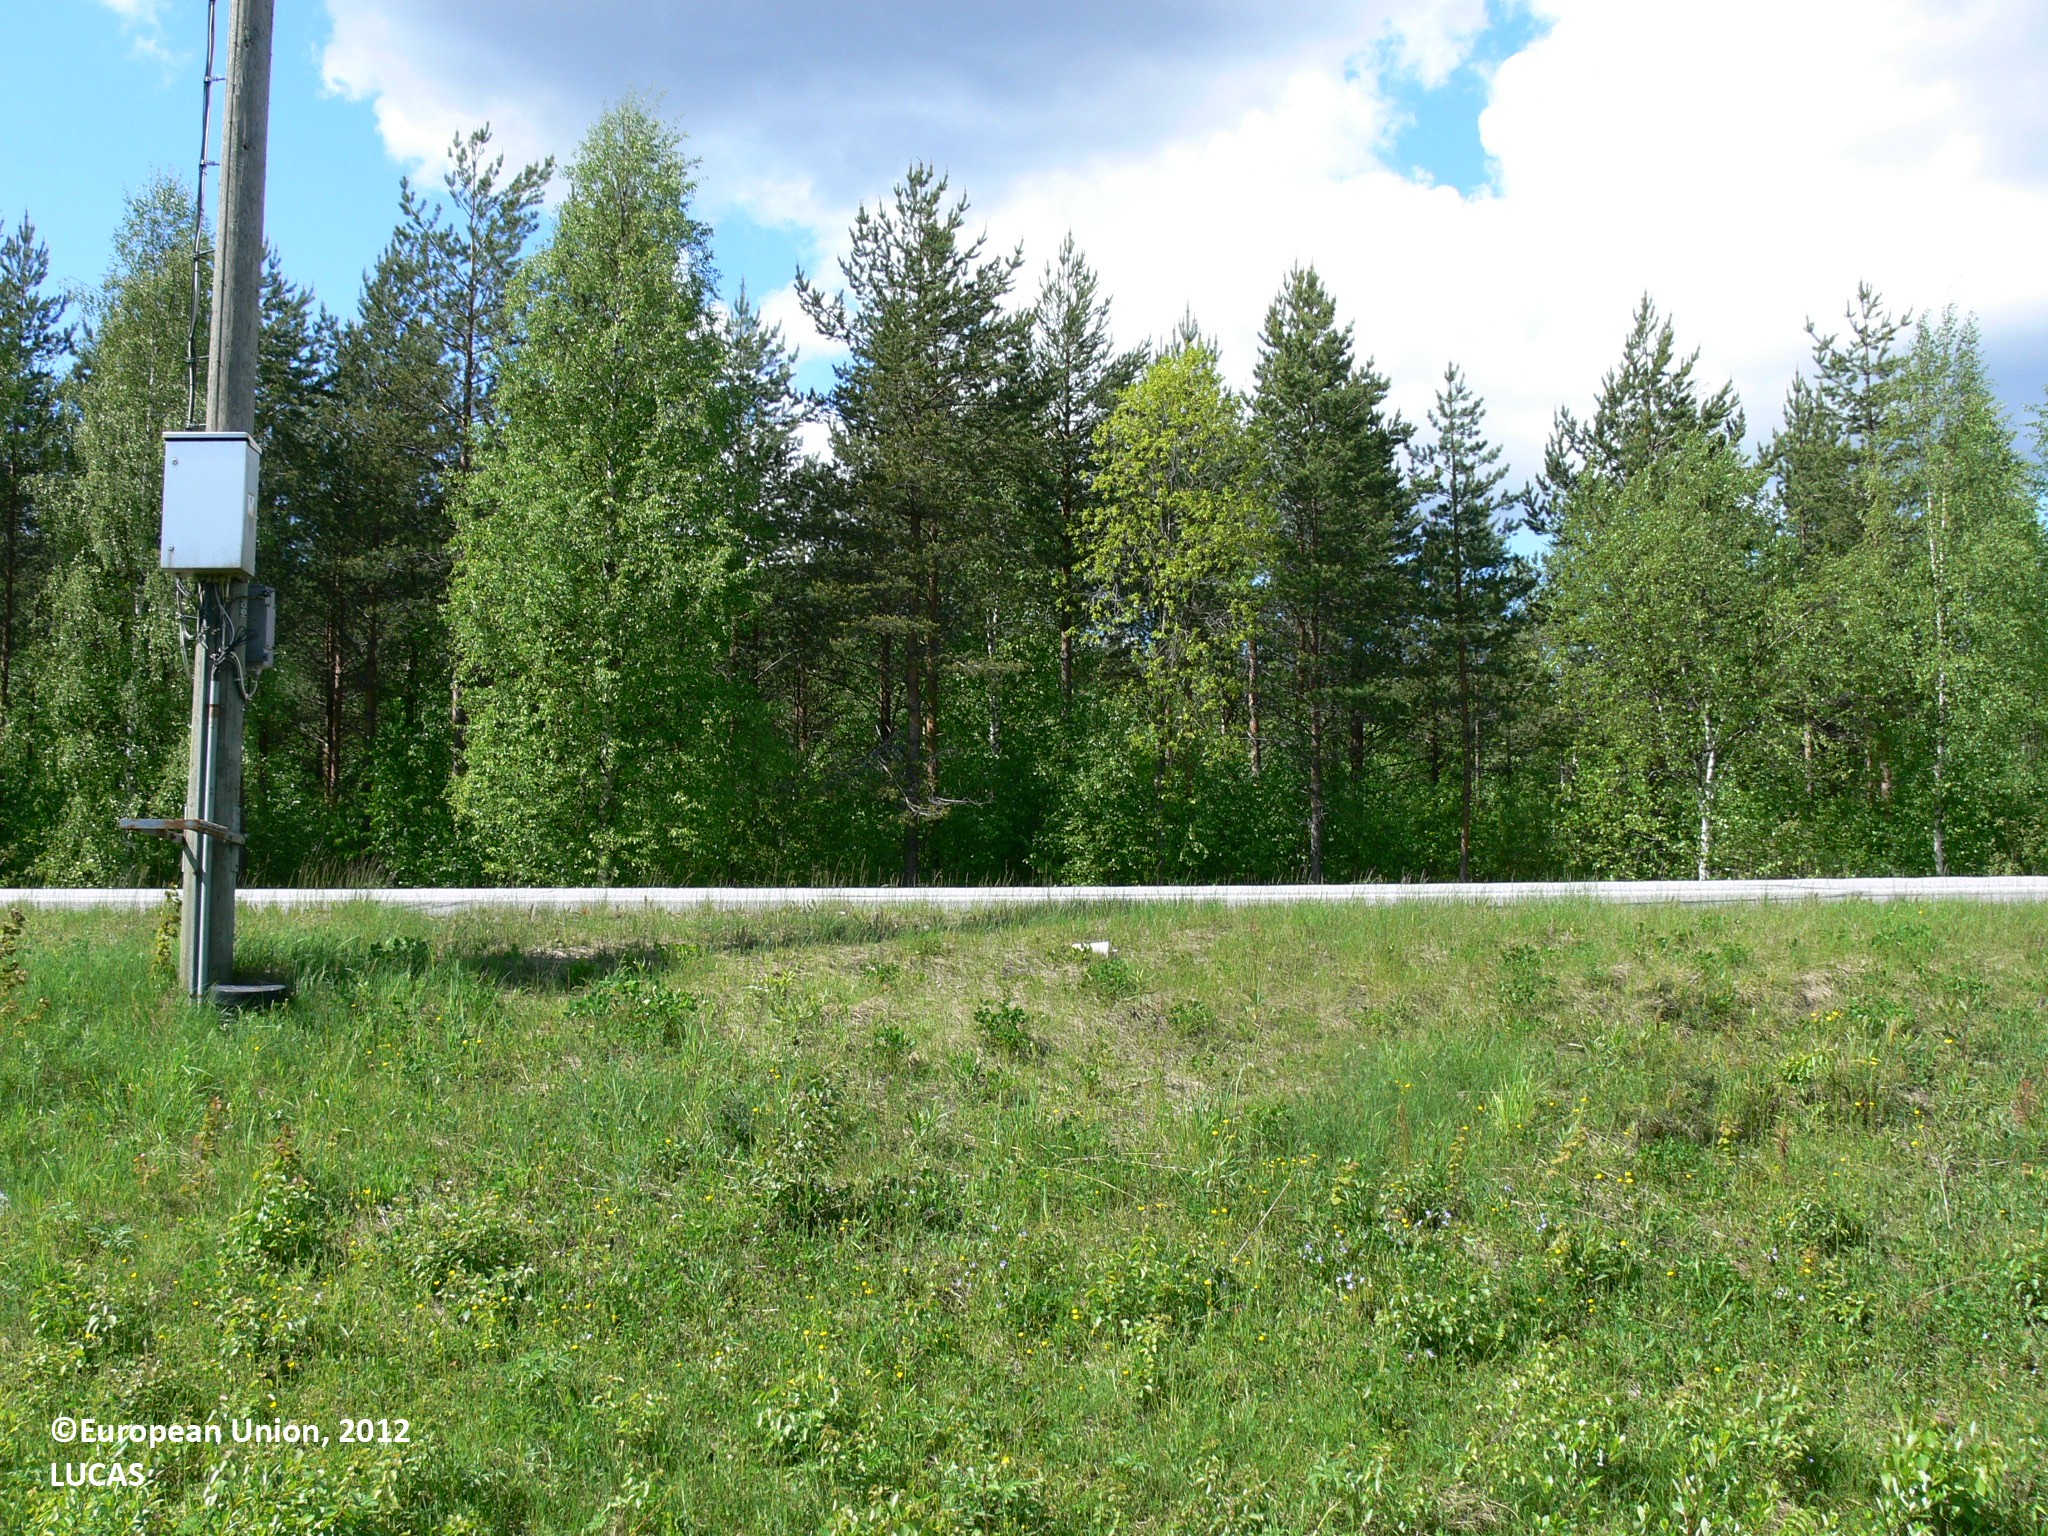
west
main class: Woodland
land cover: Broadleaved woodland
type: boreal forest
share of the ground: > 75 %
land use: Semi-natural and natural areas not in use
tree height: < 5 m
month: June
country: FI
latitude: 62.6612
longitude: 29.7869
